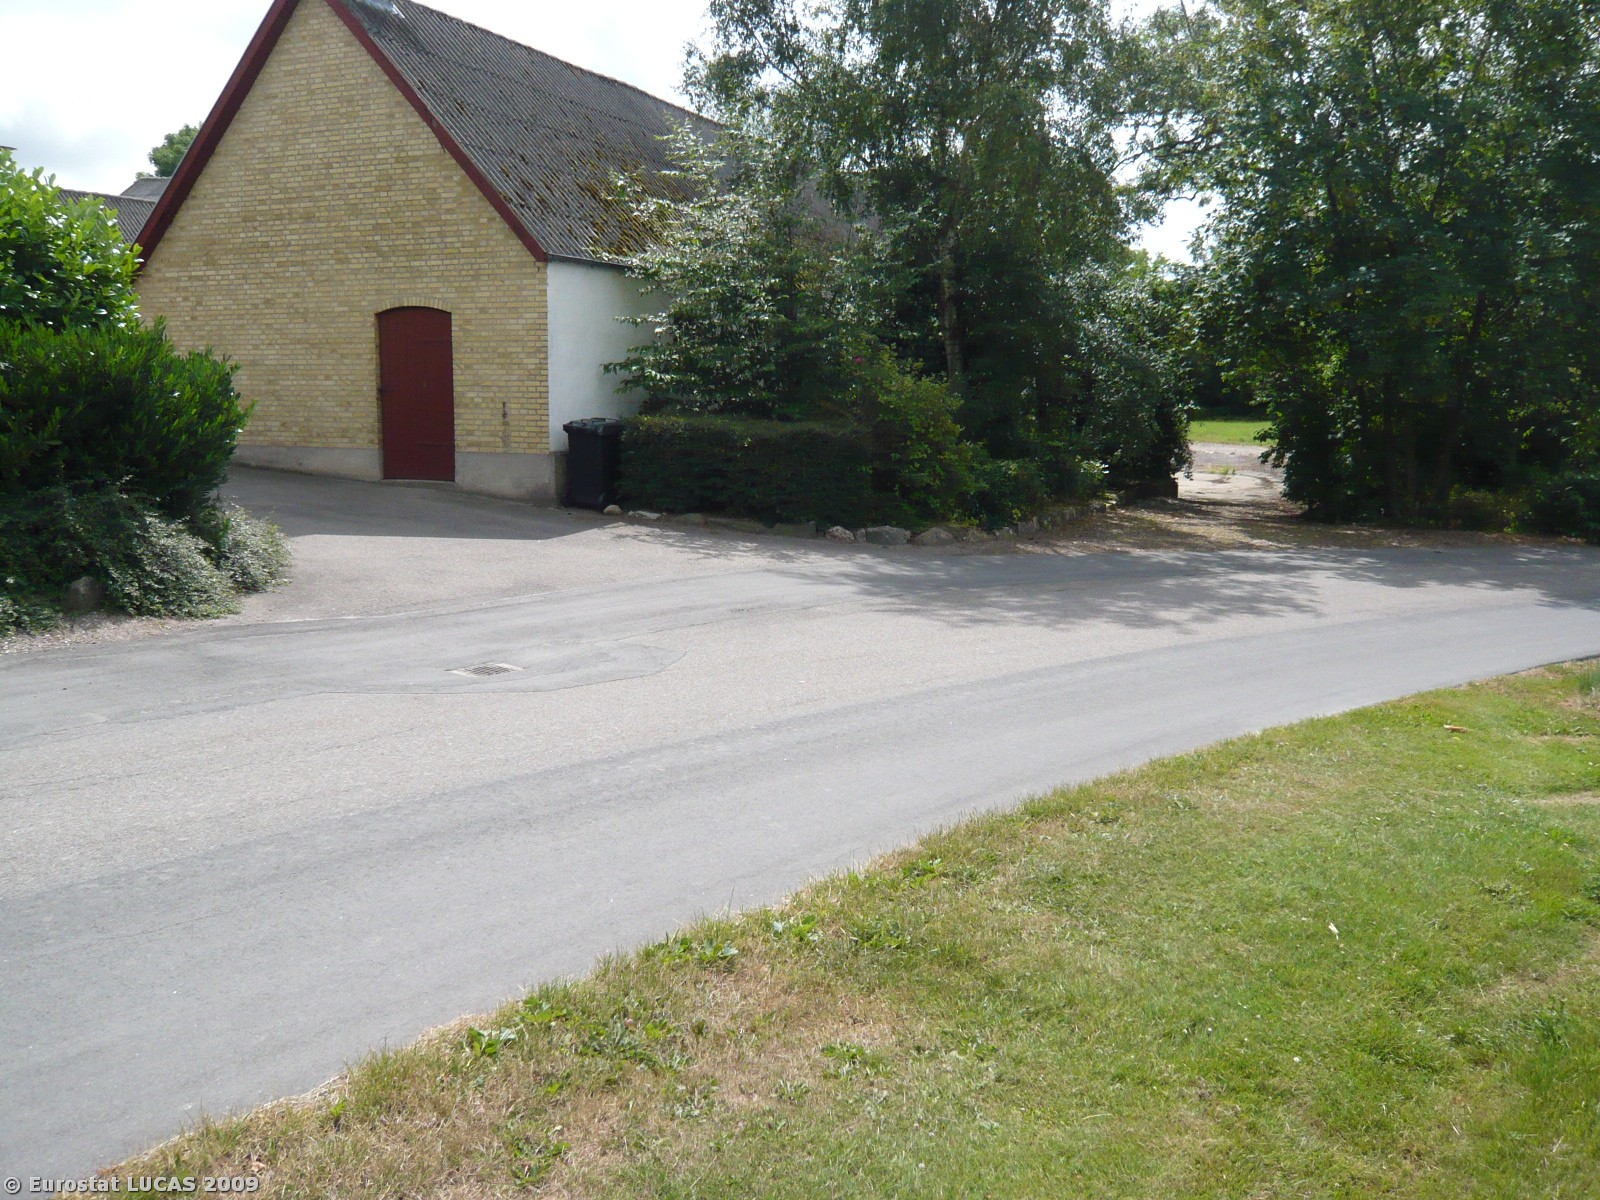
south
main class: Grassland
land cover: Grassland without tree/shrub cover
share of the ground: > 75 %
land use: Agriculture (excluding fallow land and kitchen gardens)
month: July
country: DK
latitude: 55.3538
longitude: 11.3395
